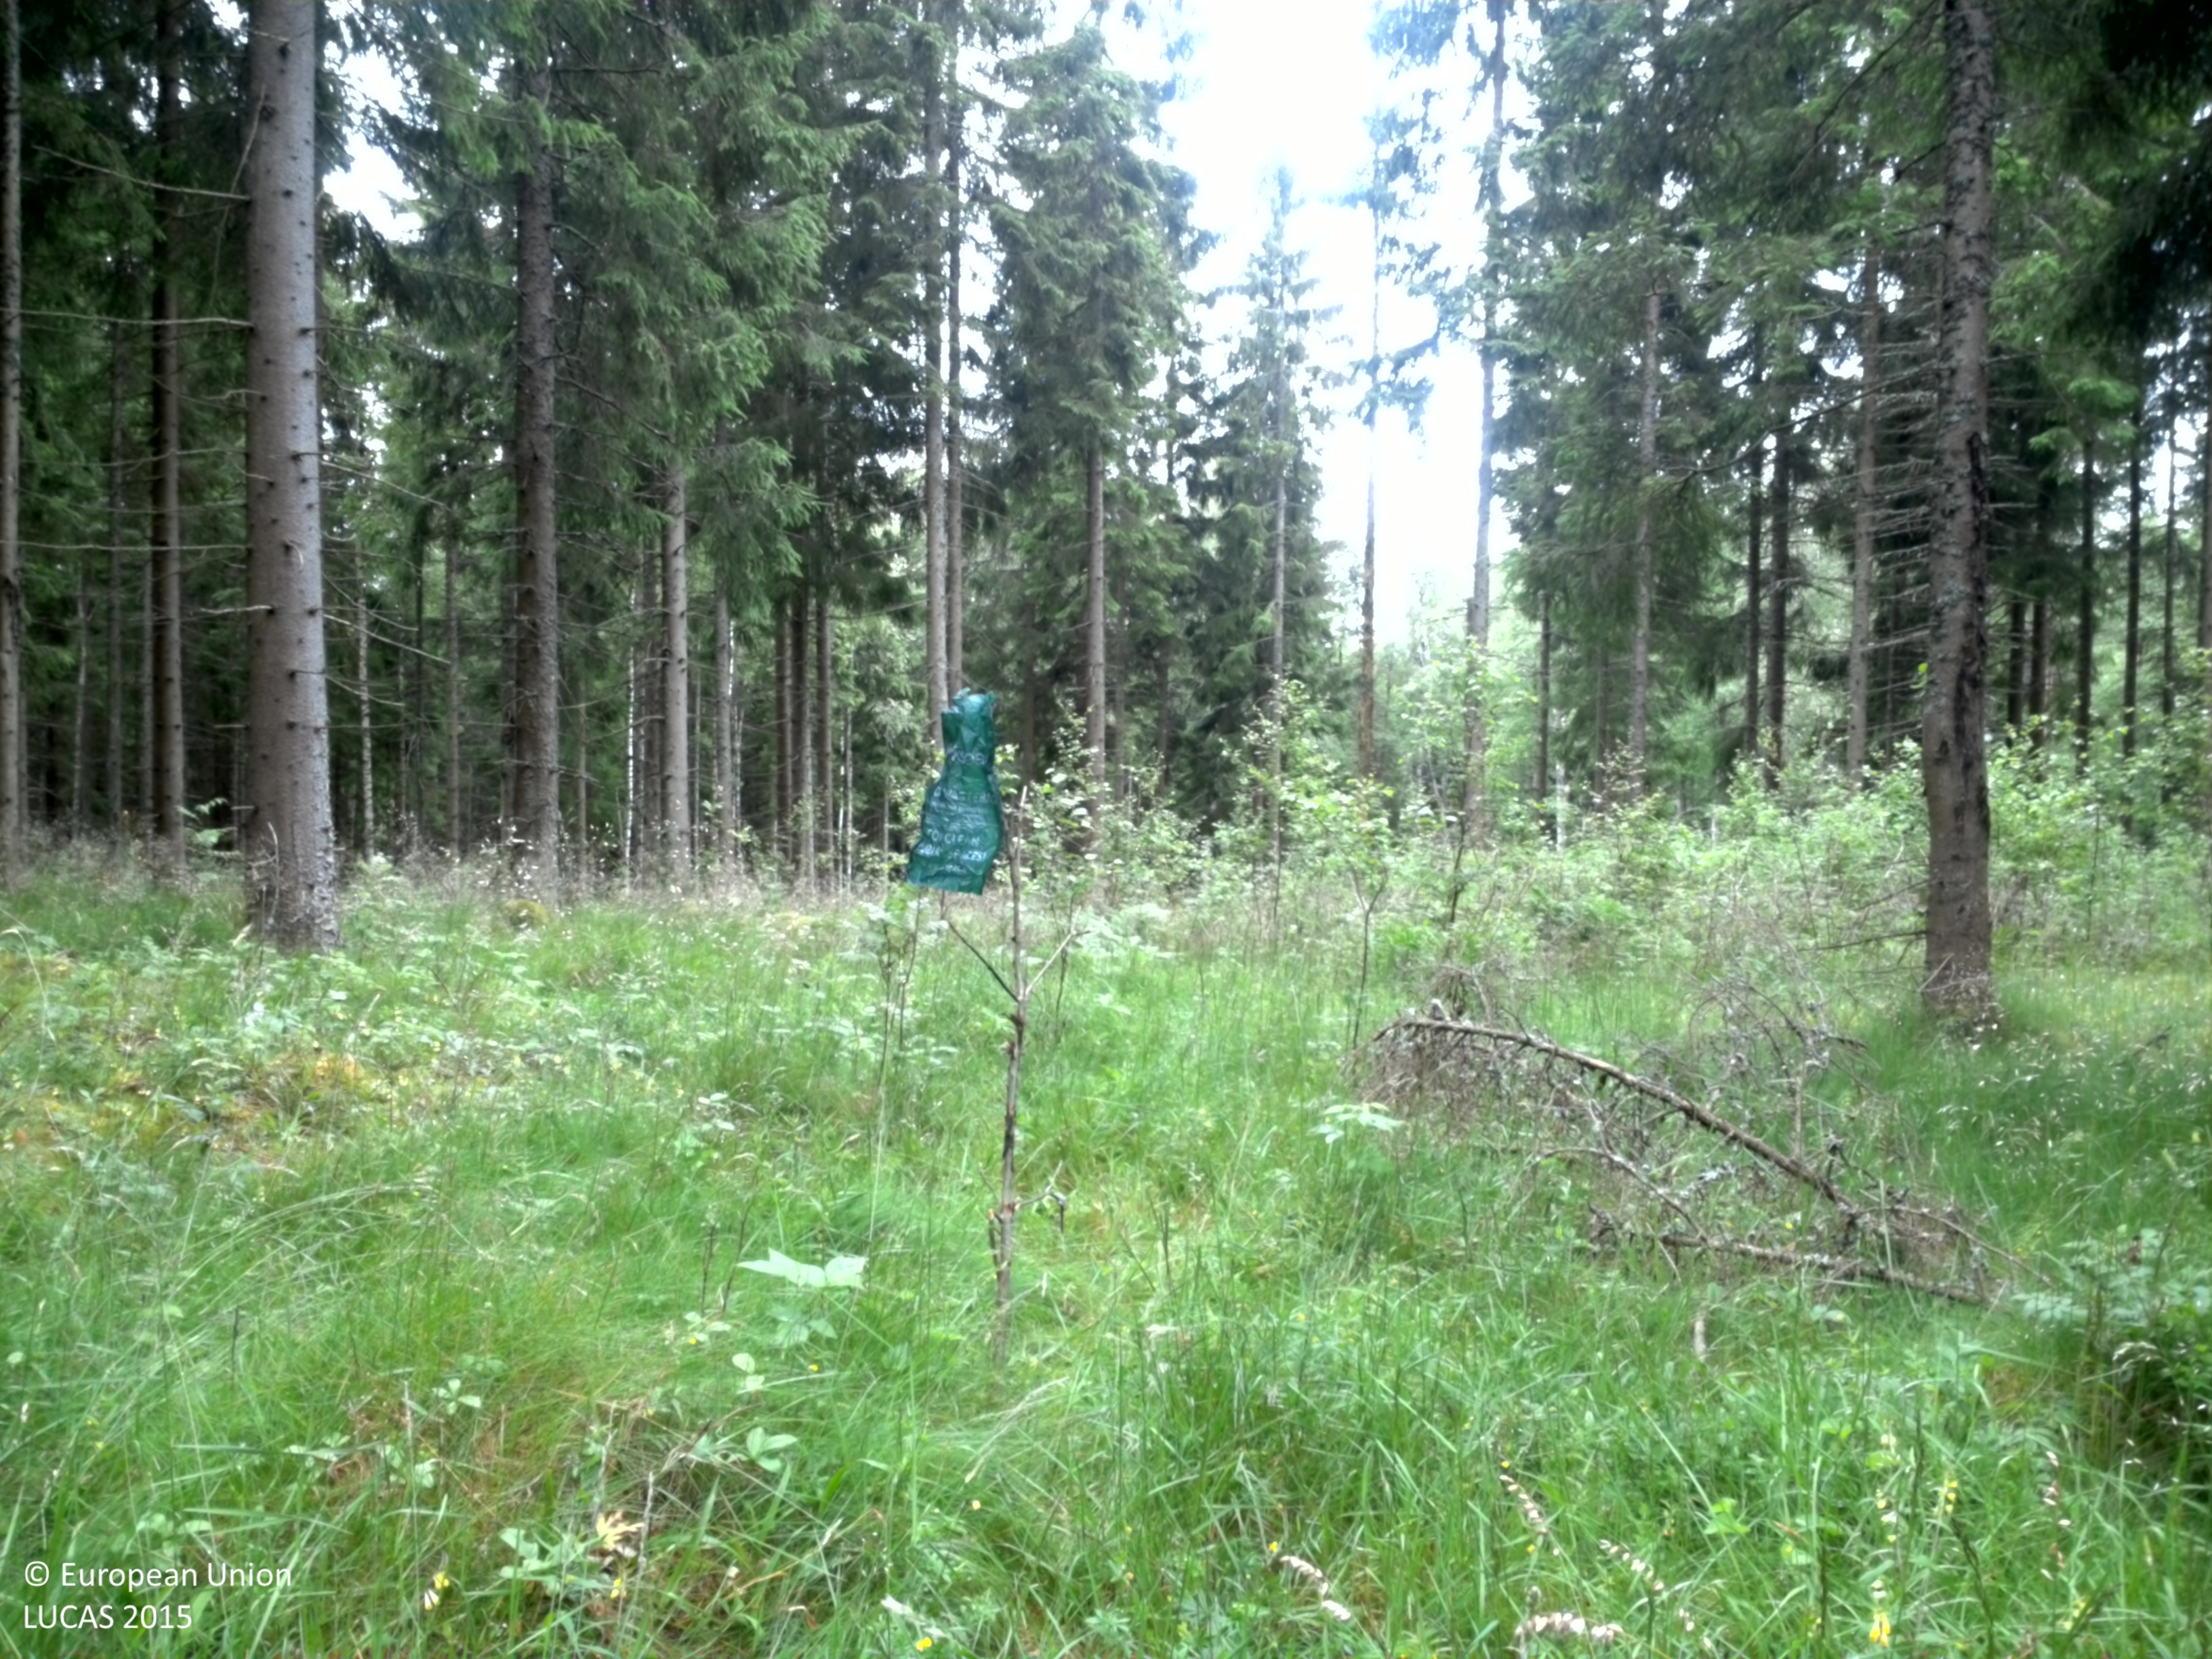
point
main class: Grassland
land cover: Grassland without tree/shrub cover
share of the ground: 50 - 75 %
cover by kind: herbaceous plants 80 %, lichens and mosses 15 %, shrubs 5 %
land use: Forestry
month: July
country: SE
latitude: 57.5523
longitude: 14.4240
